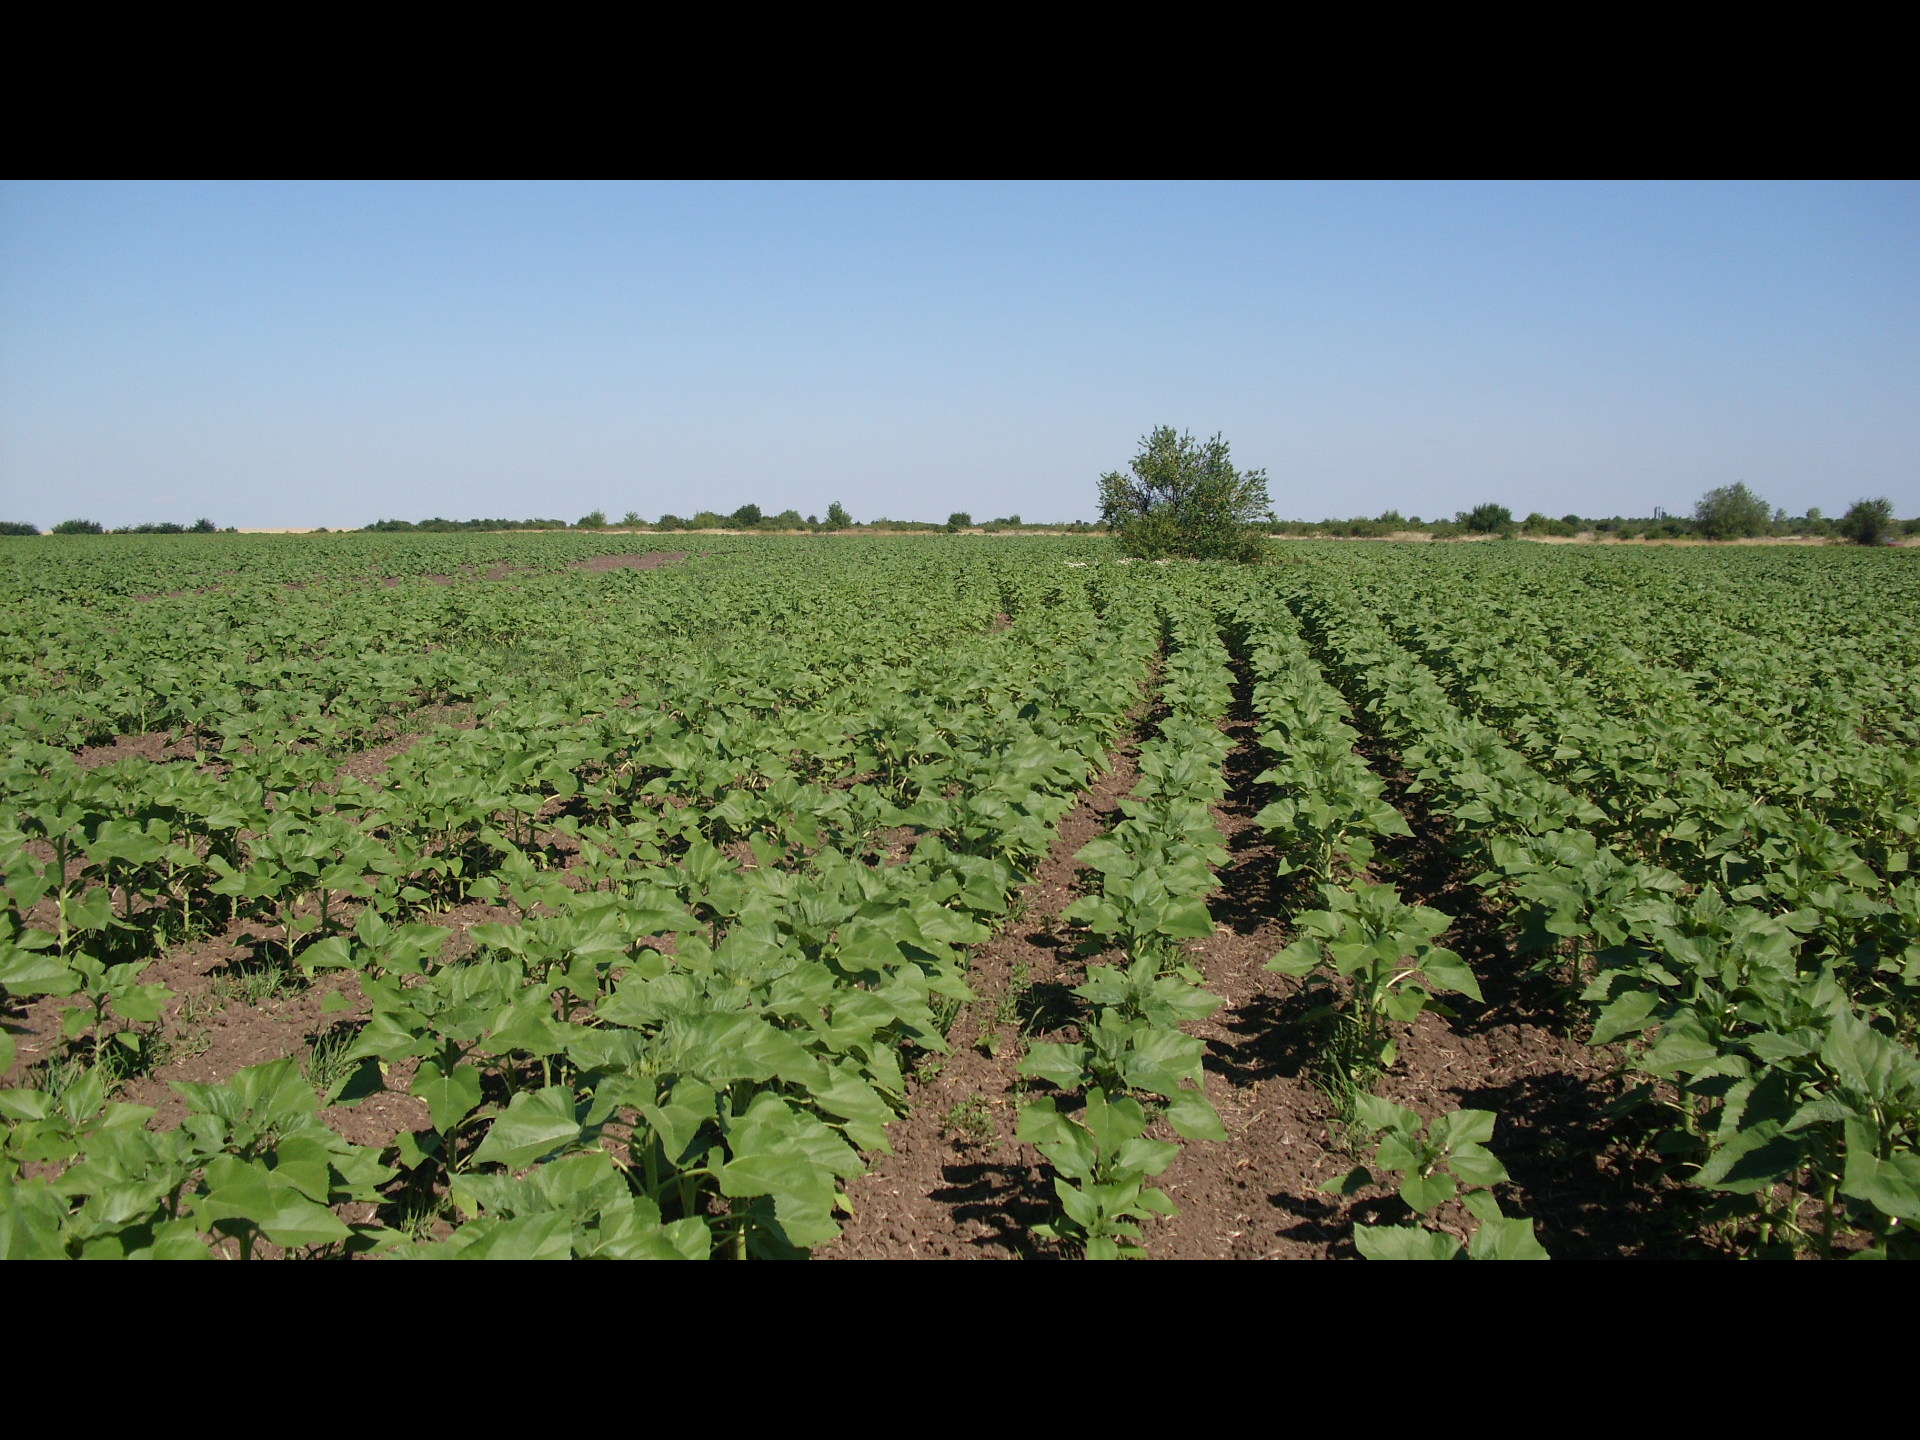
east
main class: Cropland
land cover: Sunflower
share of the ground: 50 - 75 %
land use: Agriculture (excluding fallow land and kitchen gardens)
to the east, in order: Sunflower; Single bushes/trees; Sunflower
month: June
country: BG
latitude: 43.5516
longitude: 23.2486
